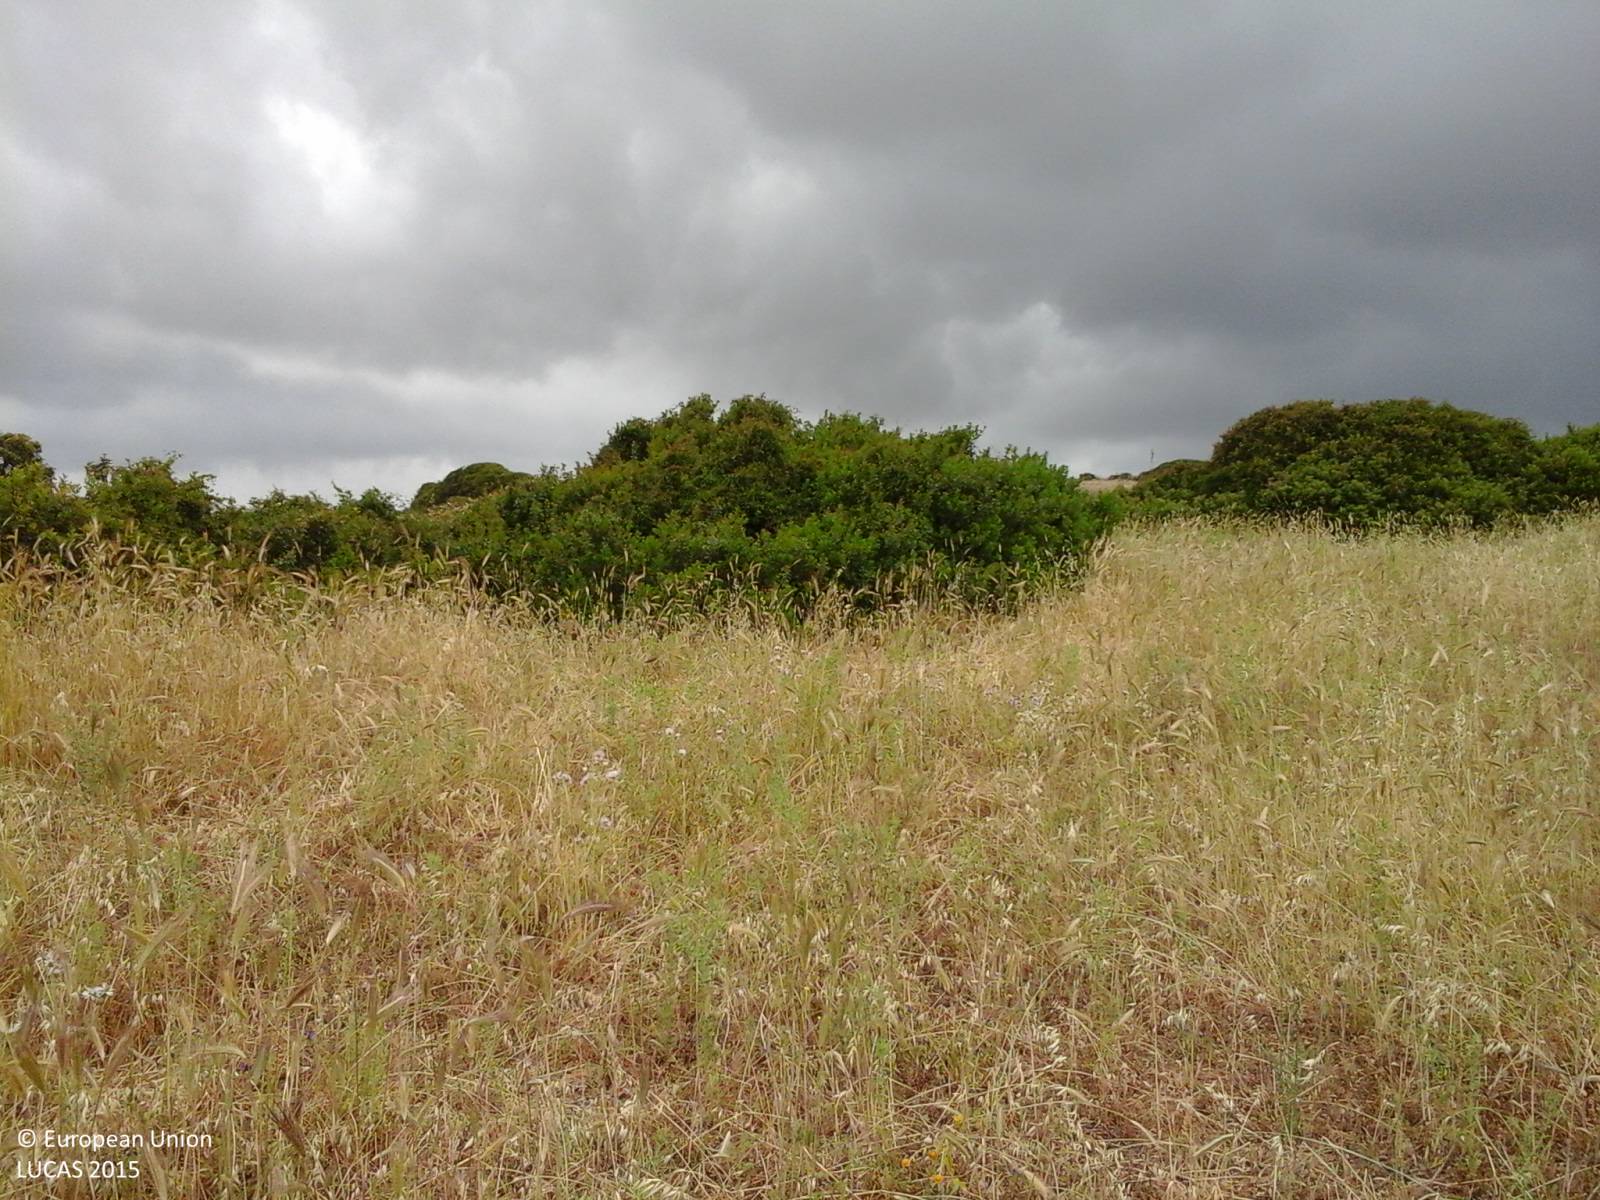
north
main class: Grassland
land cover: Spontaneously vegetated surfaces
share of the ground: > 75 %
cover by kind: herbaceous plants 100 %
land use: Agriculture (excluding fallow land and kitchen gardens)
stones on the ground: 25 - 50 %
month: May
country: IT
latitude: 39.8625
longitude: 8.8724
